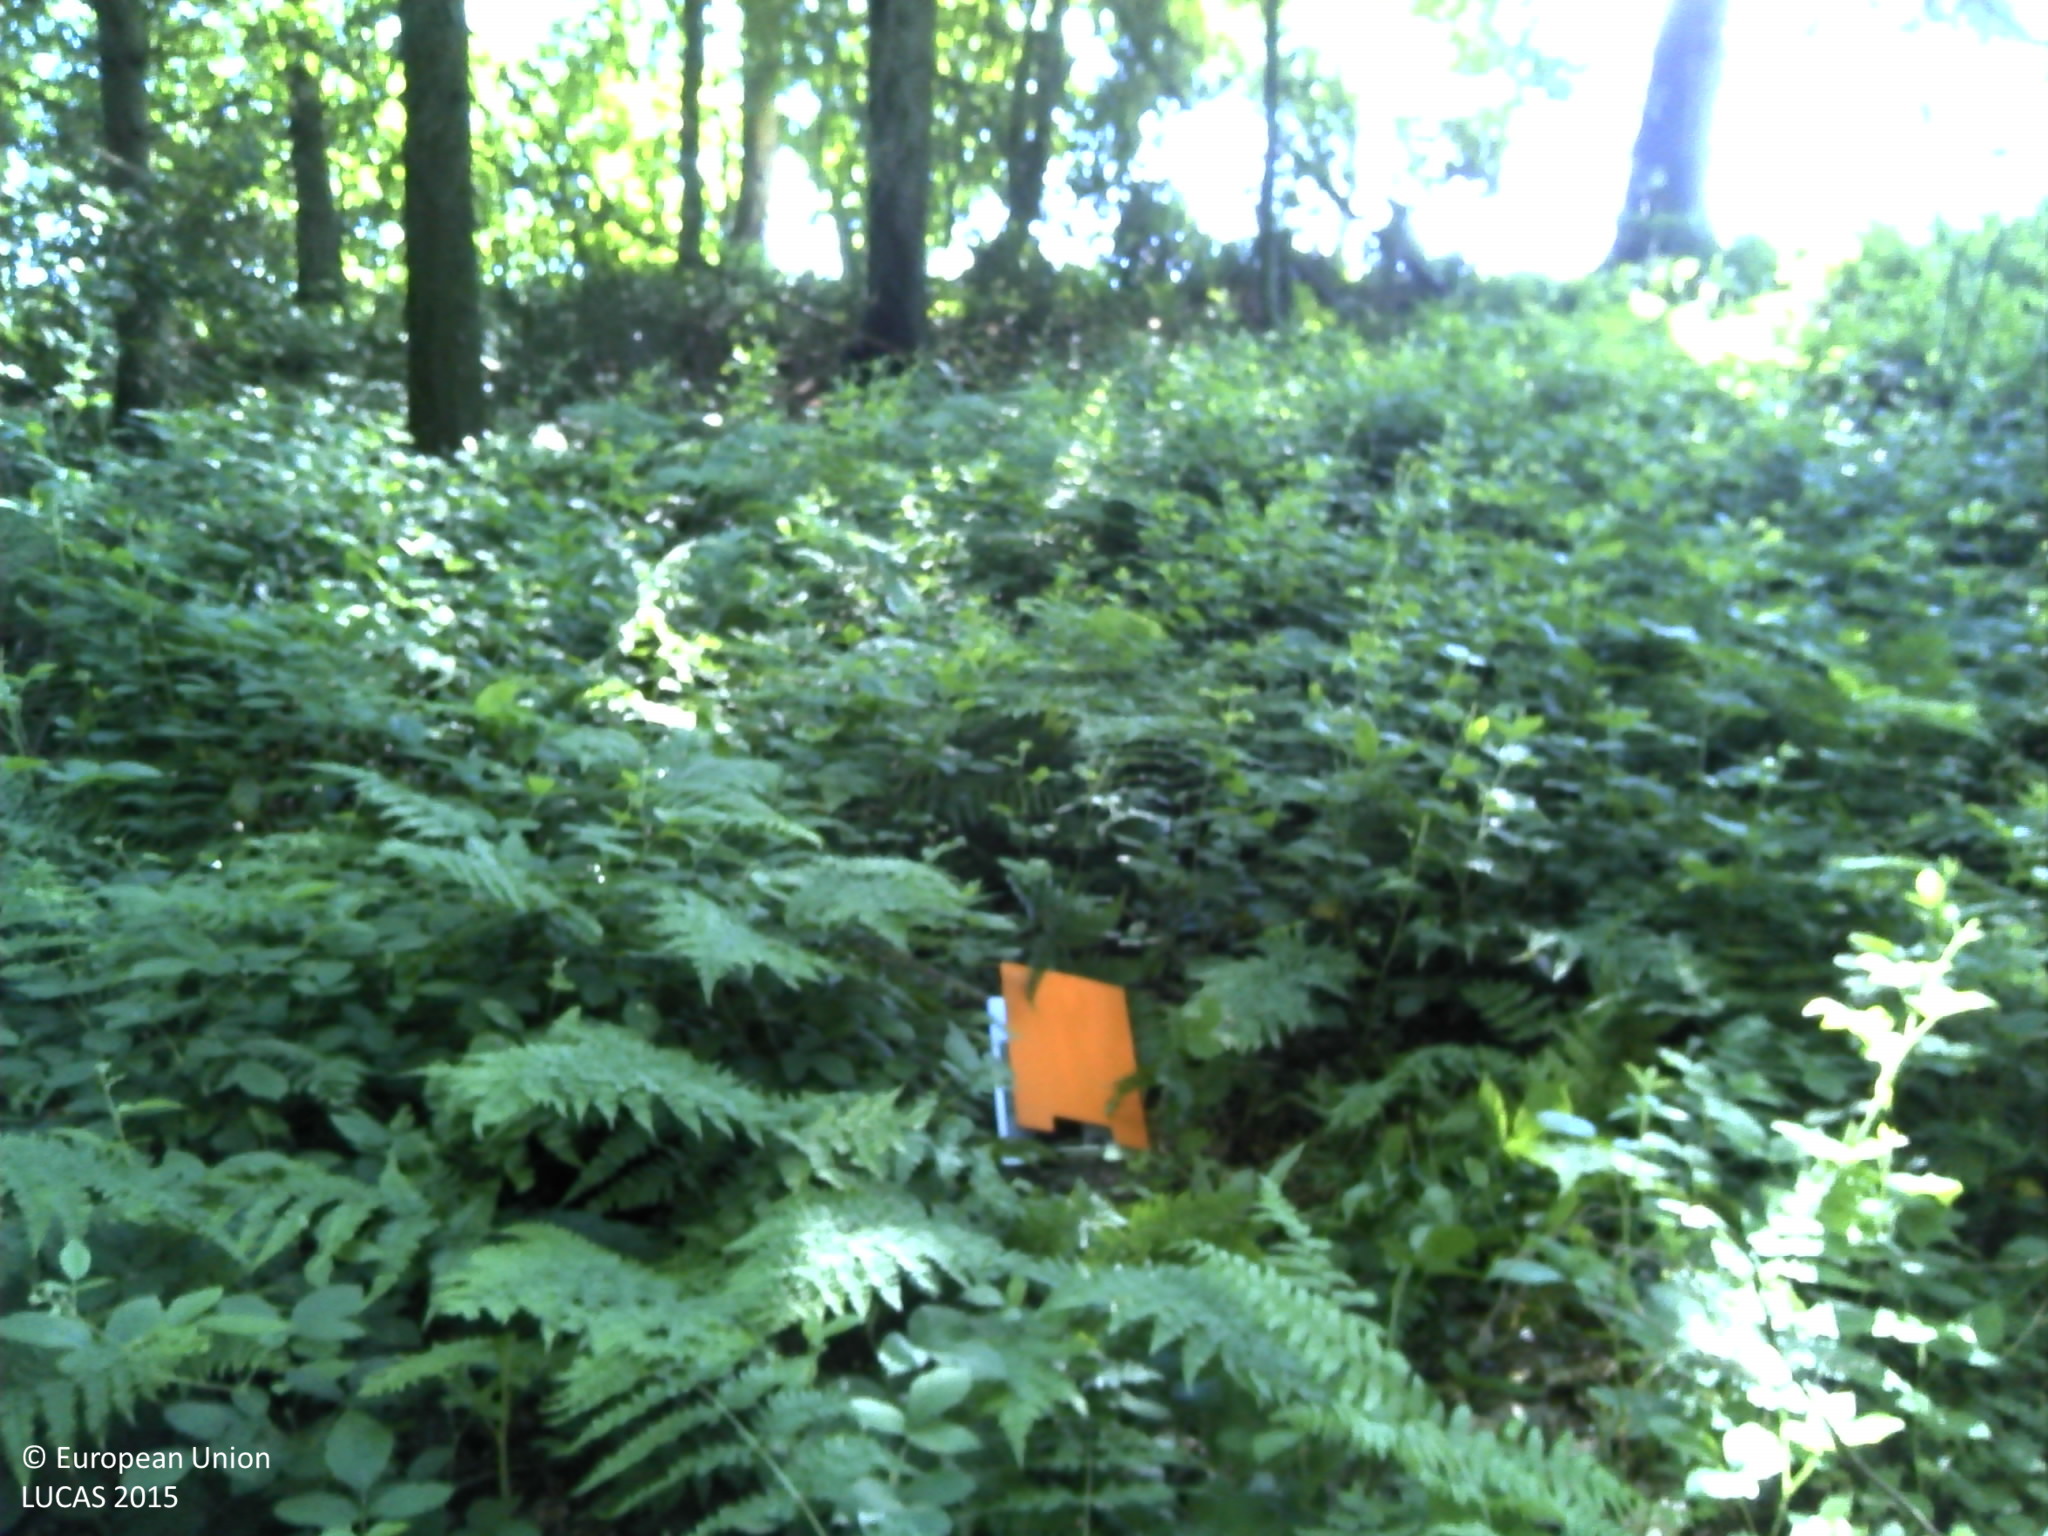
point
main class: Woodland
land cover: Spruce dominated mixed woodland
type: beech forest
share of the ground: > 75 %
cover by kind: coniferous forest trees 45 %, broadleaved forest trees 45 %, herbaceous plants 10 %
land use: Forestry
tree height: > 5 m
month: June
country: FR
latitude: 49.5633
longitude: 1.0883
